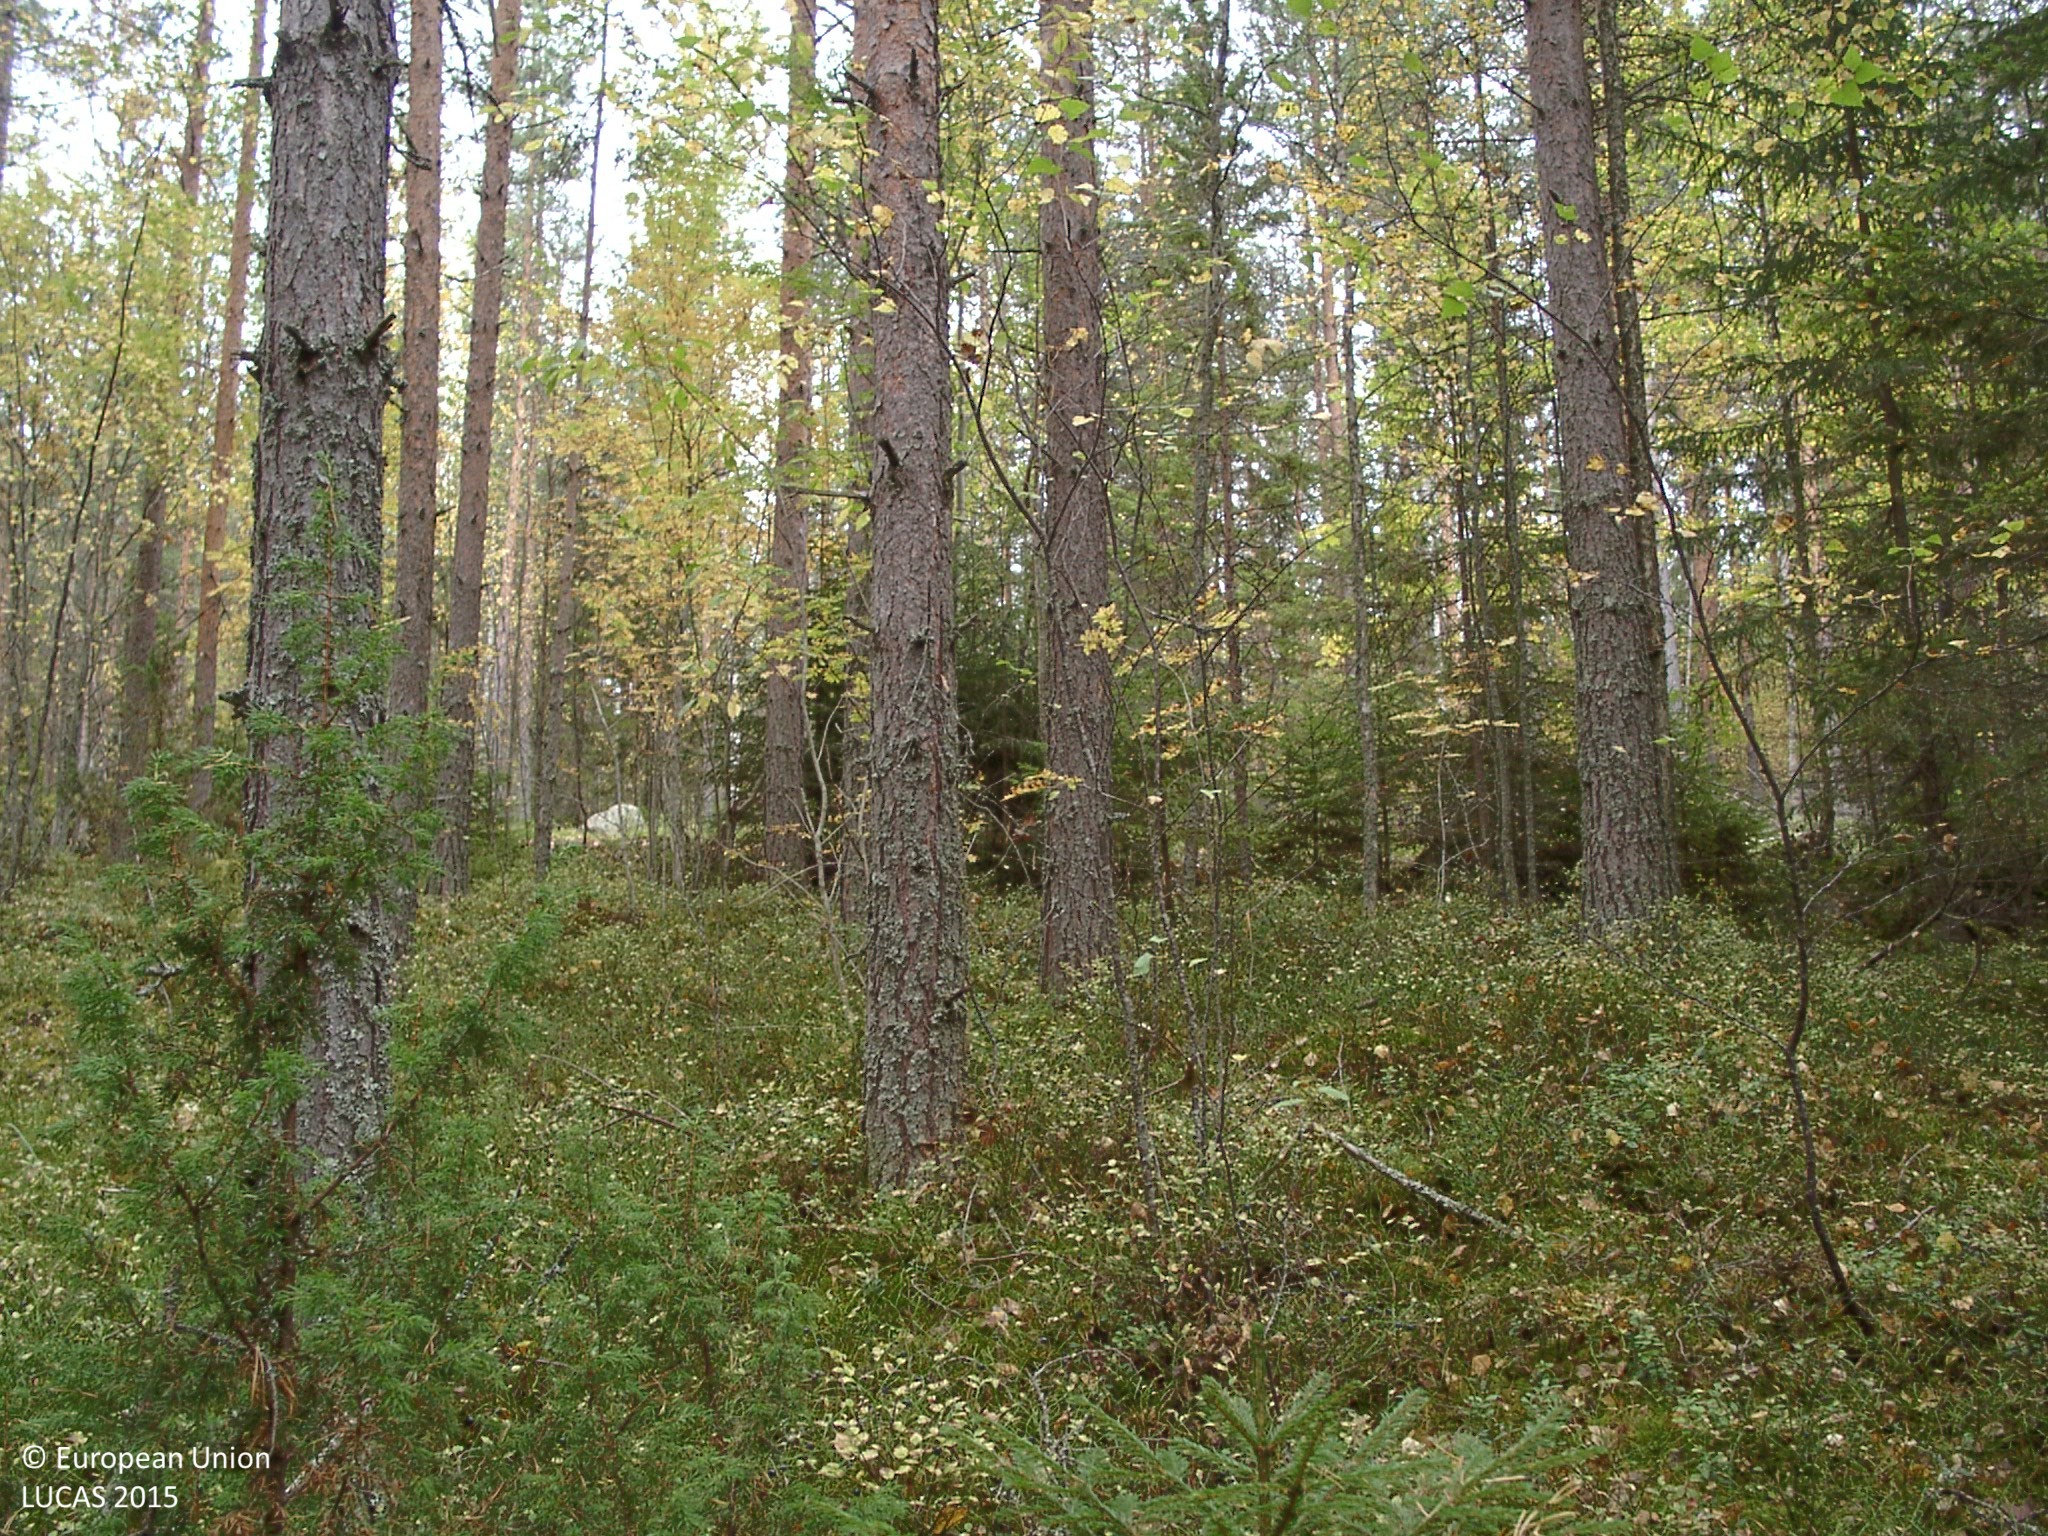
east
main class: Woodland
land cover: Pine dominated mixed woodland
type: boreal forest
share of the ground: 50 - 75 %
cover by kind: coniferous forest trees 50 %, broadleaved forest trees 20 %, shrubs 15 %, lichens and mosses 15 %
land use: Forestry
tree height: > 5 m
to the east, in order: Pine dominated mixed woodland; Tracks; Electric lines; Shrubland with sparse tree cover; Pine dominated coniferous woodland; Other coniferous woodland
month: September
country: FI
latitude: 62.6973
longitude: 25.4088
